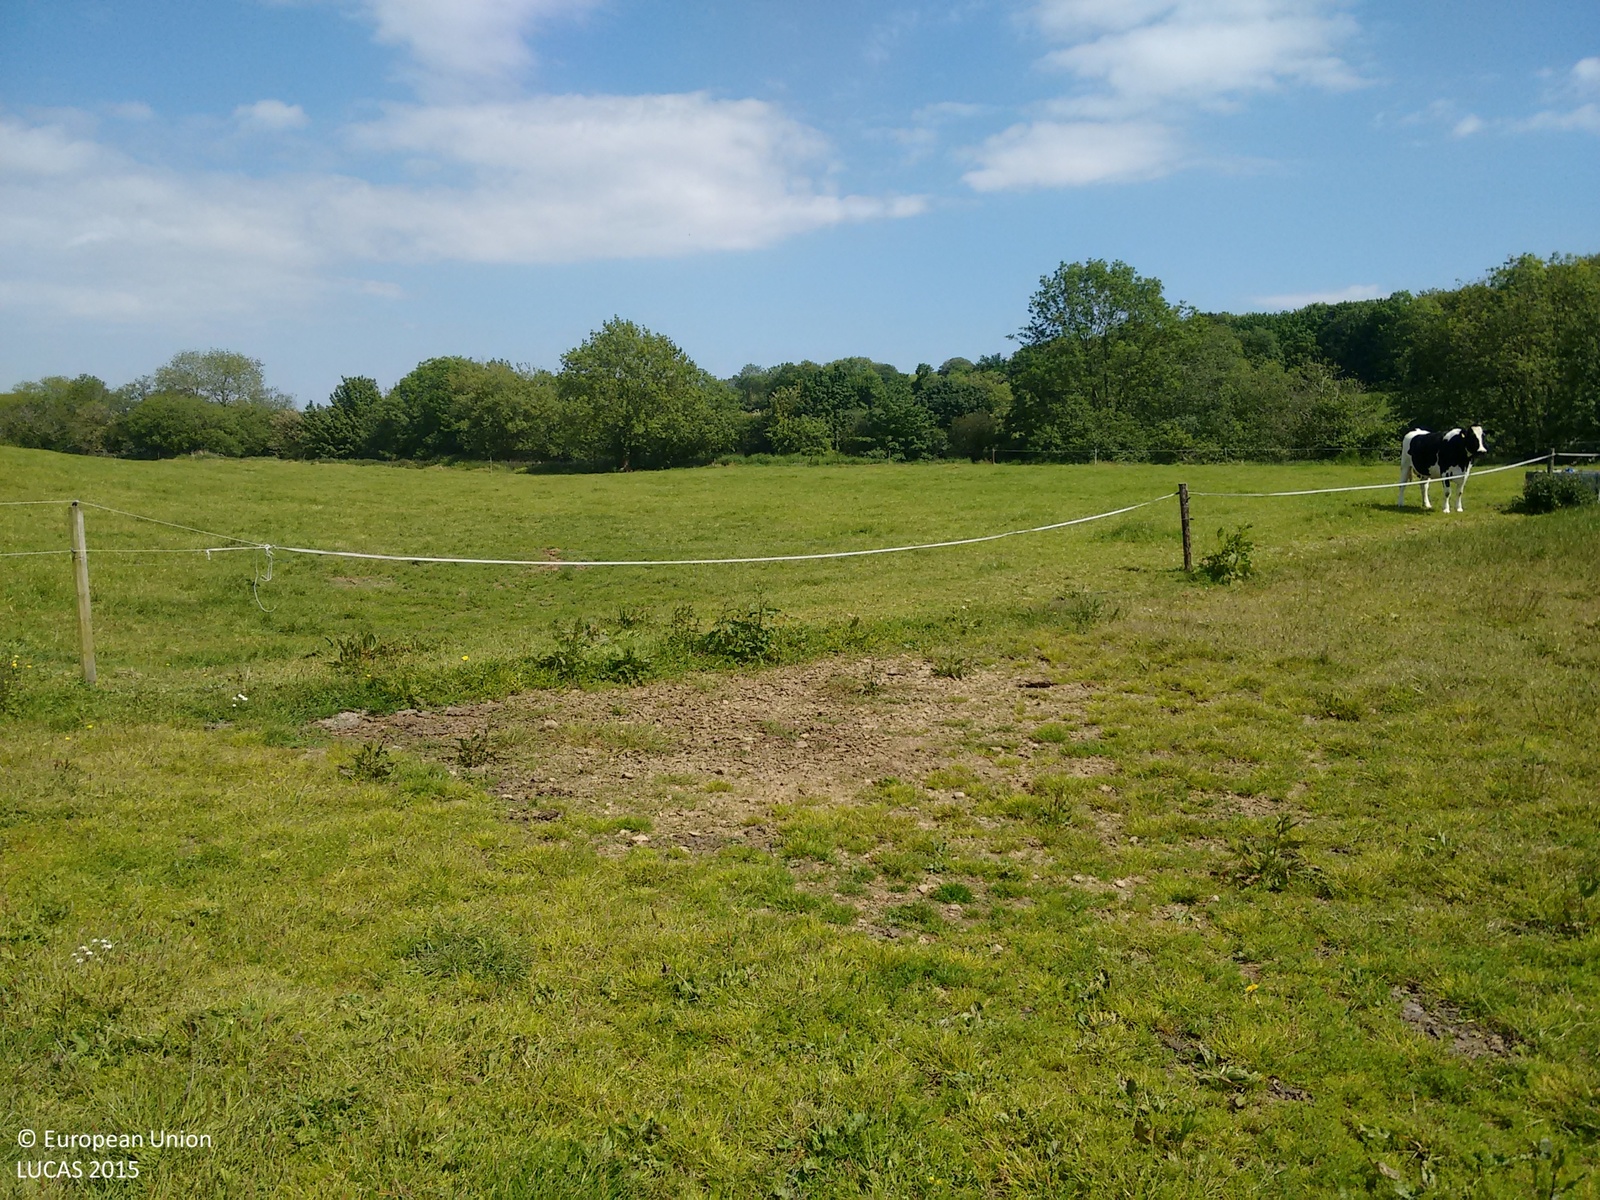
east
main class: Grassland
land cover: Grassland without tree/shrub cover
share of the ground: > 75 %
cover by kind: herbaceous plants 100 %
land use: Agriculture (excluding fallow land and kitchen gardens)
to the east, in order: Grassland without tree/shrub cover; Fences; Broadleaved woodland; Inland fresh running water; Broadleaved woodland; Fences; Grassland without tree/shrub cover; Fences; Grassland without tree/shrub cover
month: June
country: IE
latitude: 51.7354
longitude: -8.8431
